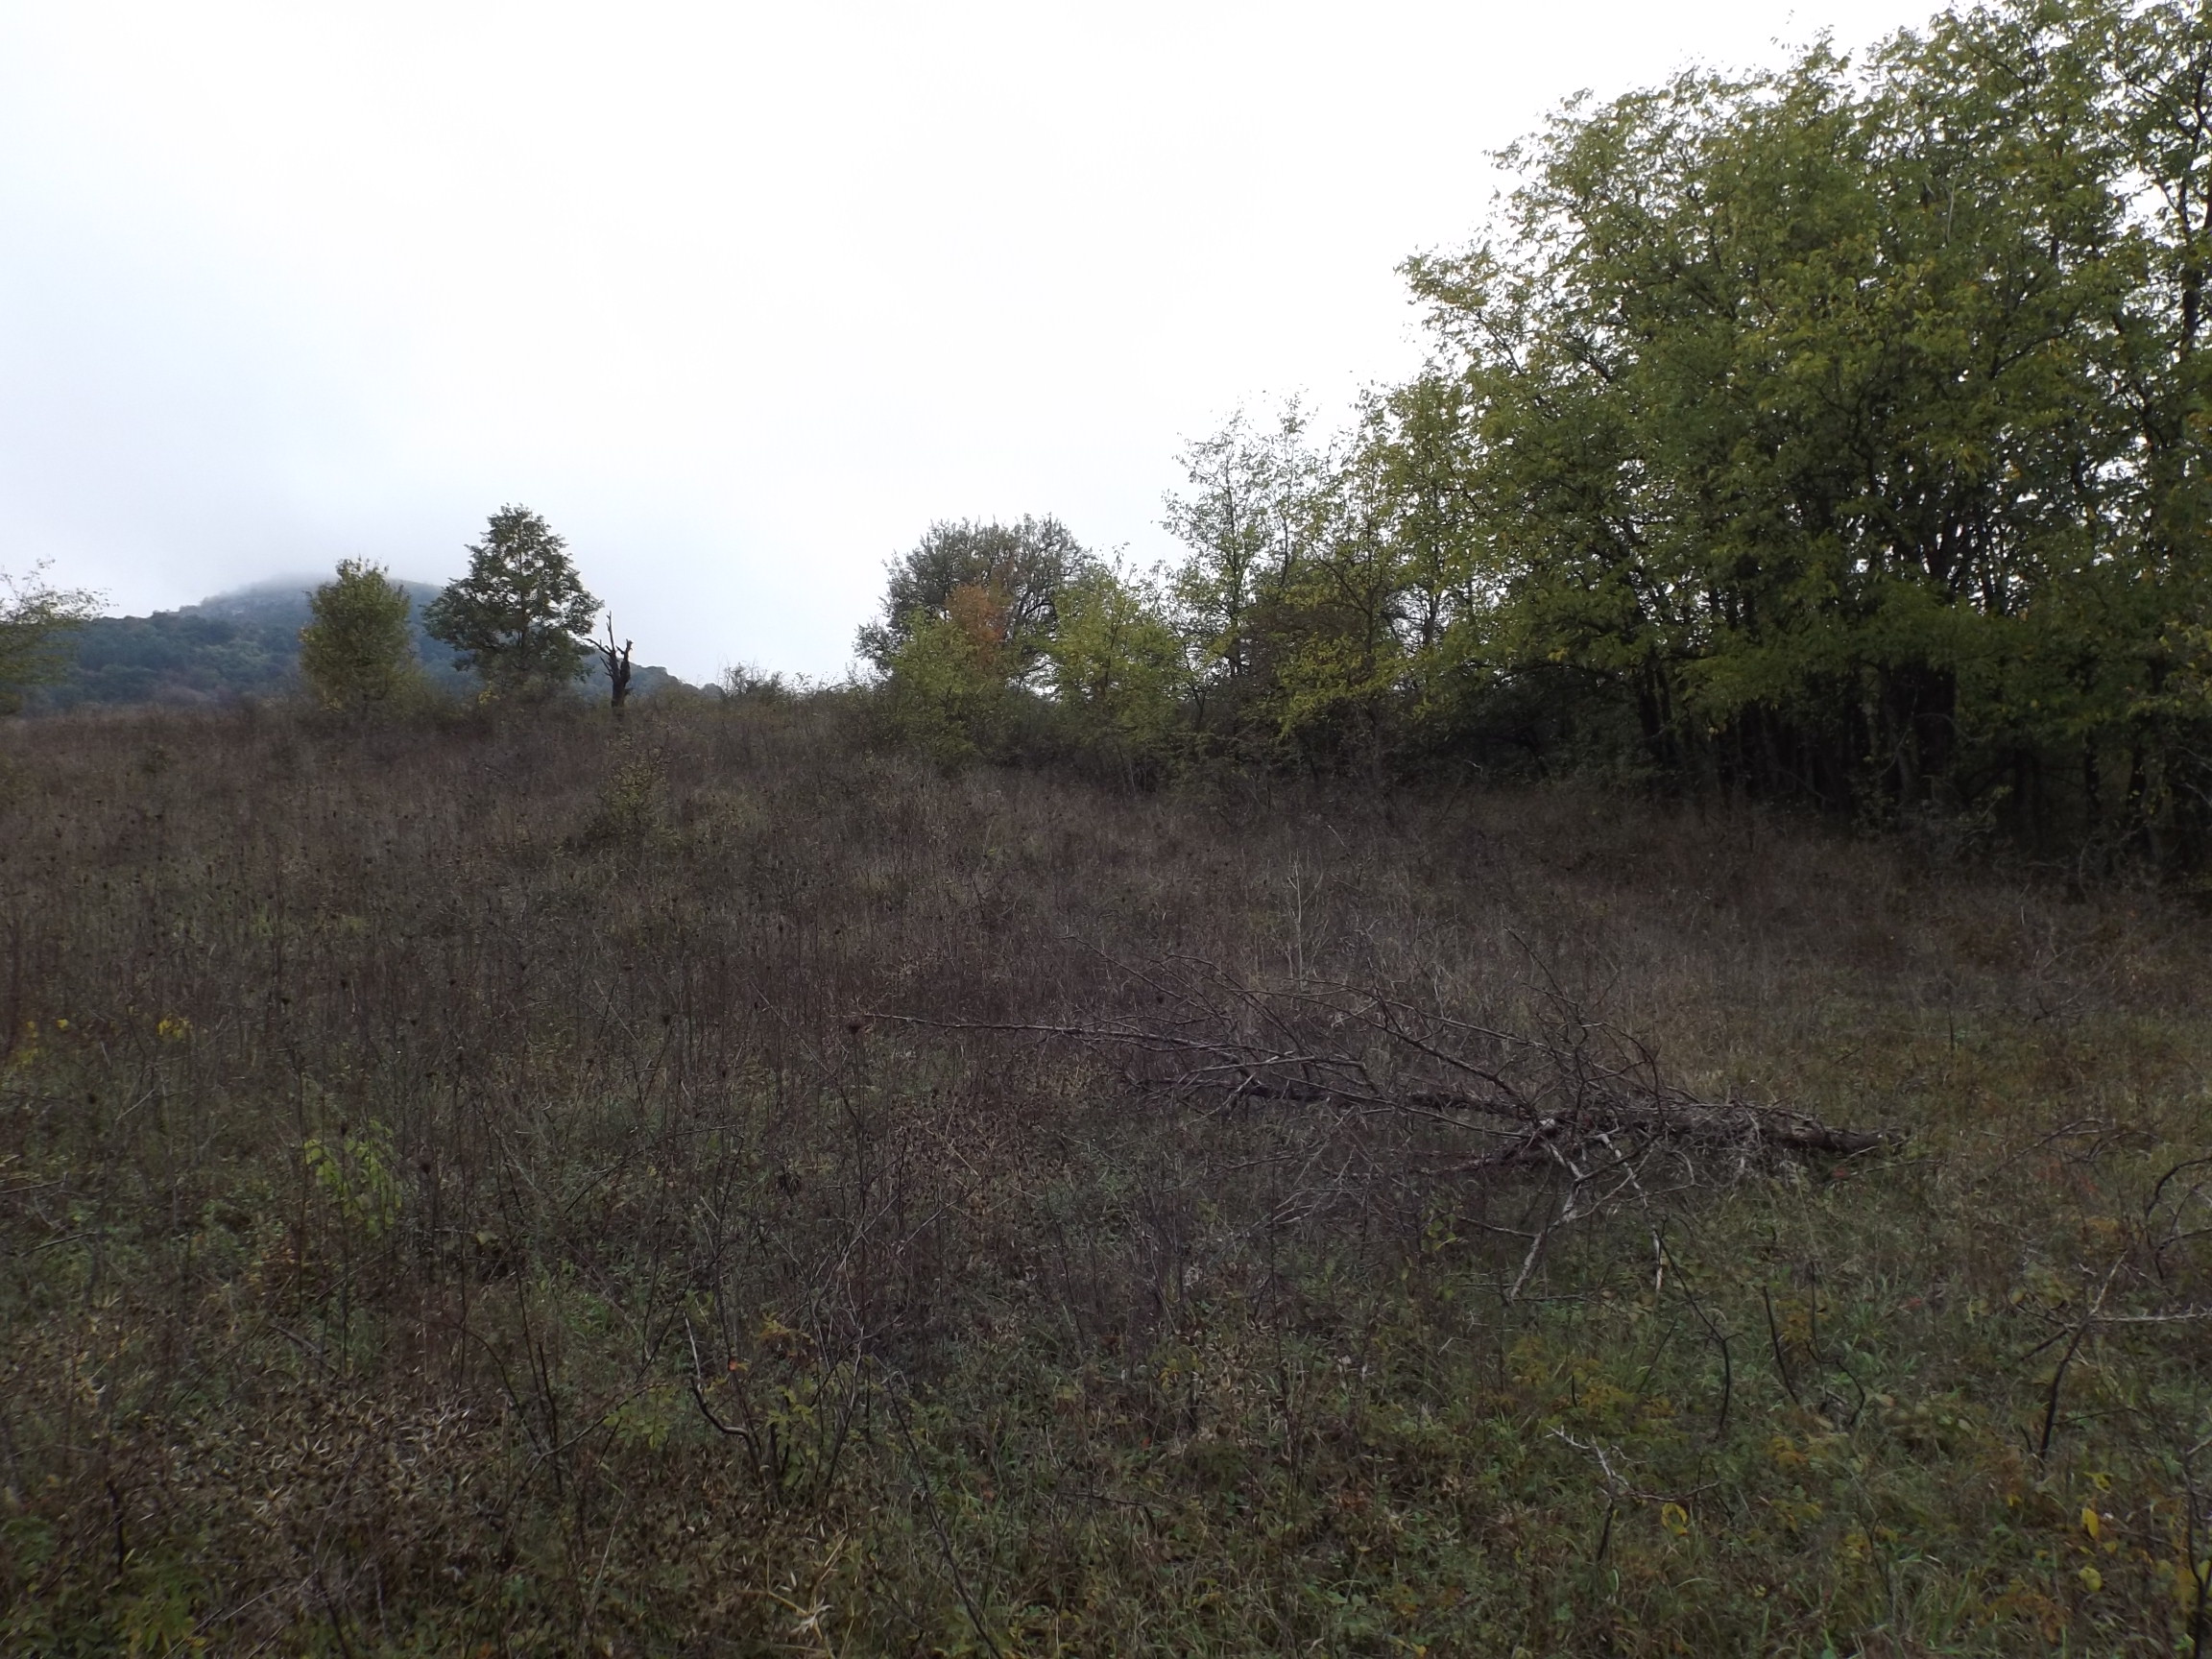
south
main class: Shrubland
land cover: Shrubland with sparse tree cover
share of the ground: 50 - 75 %
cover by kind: shrubs 55 %, herbaceous plants 40 %, broadleaved forest trees 5 %
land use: Semi-natural and natural areas not in use
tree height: > 5 m
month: October
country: BG
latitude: 43.0320
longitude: 27.1884
